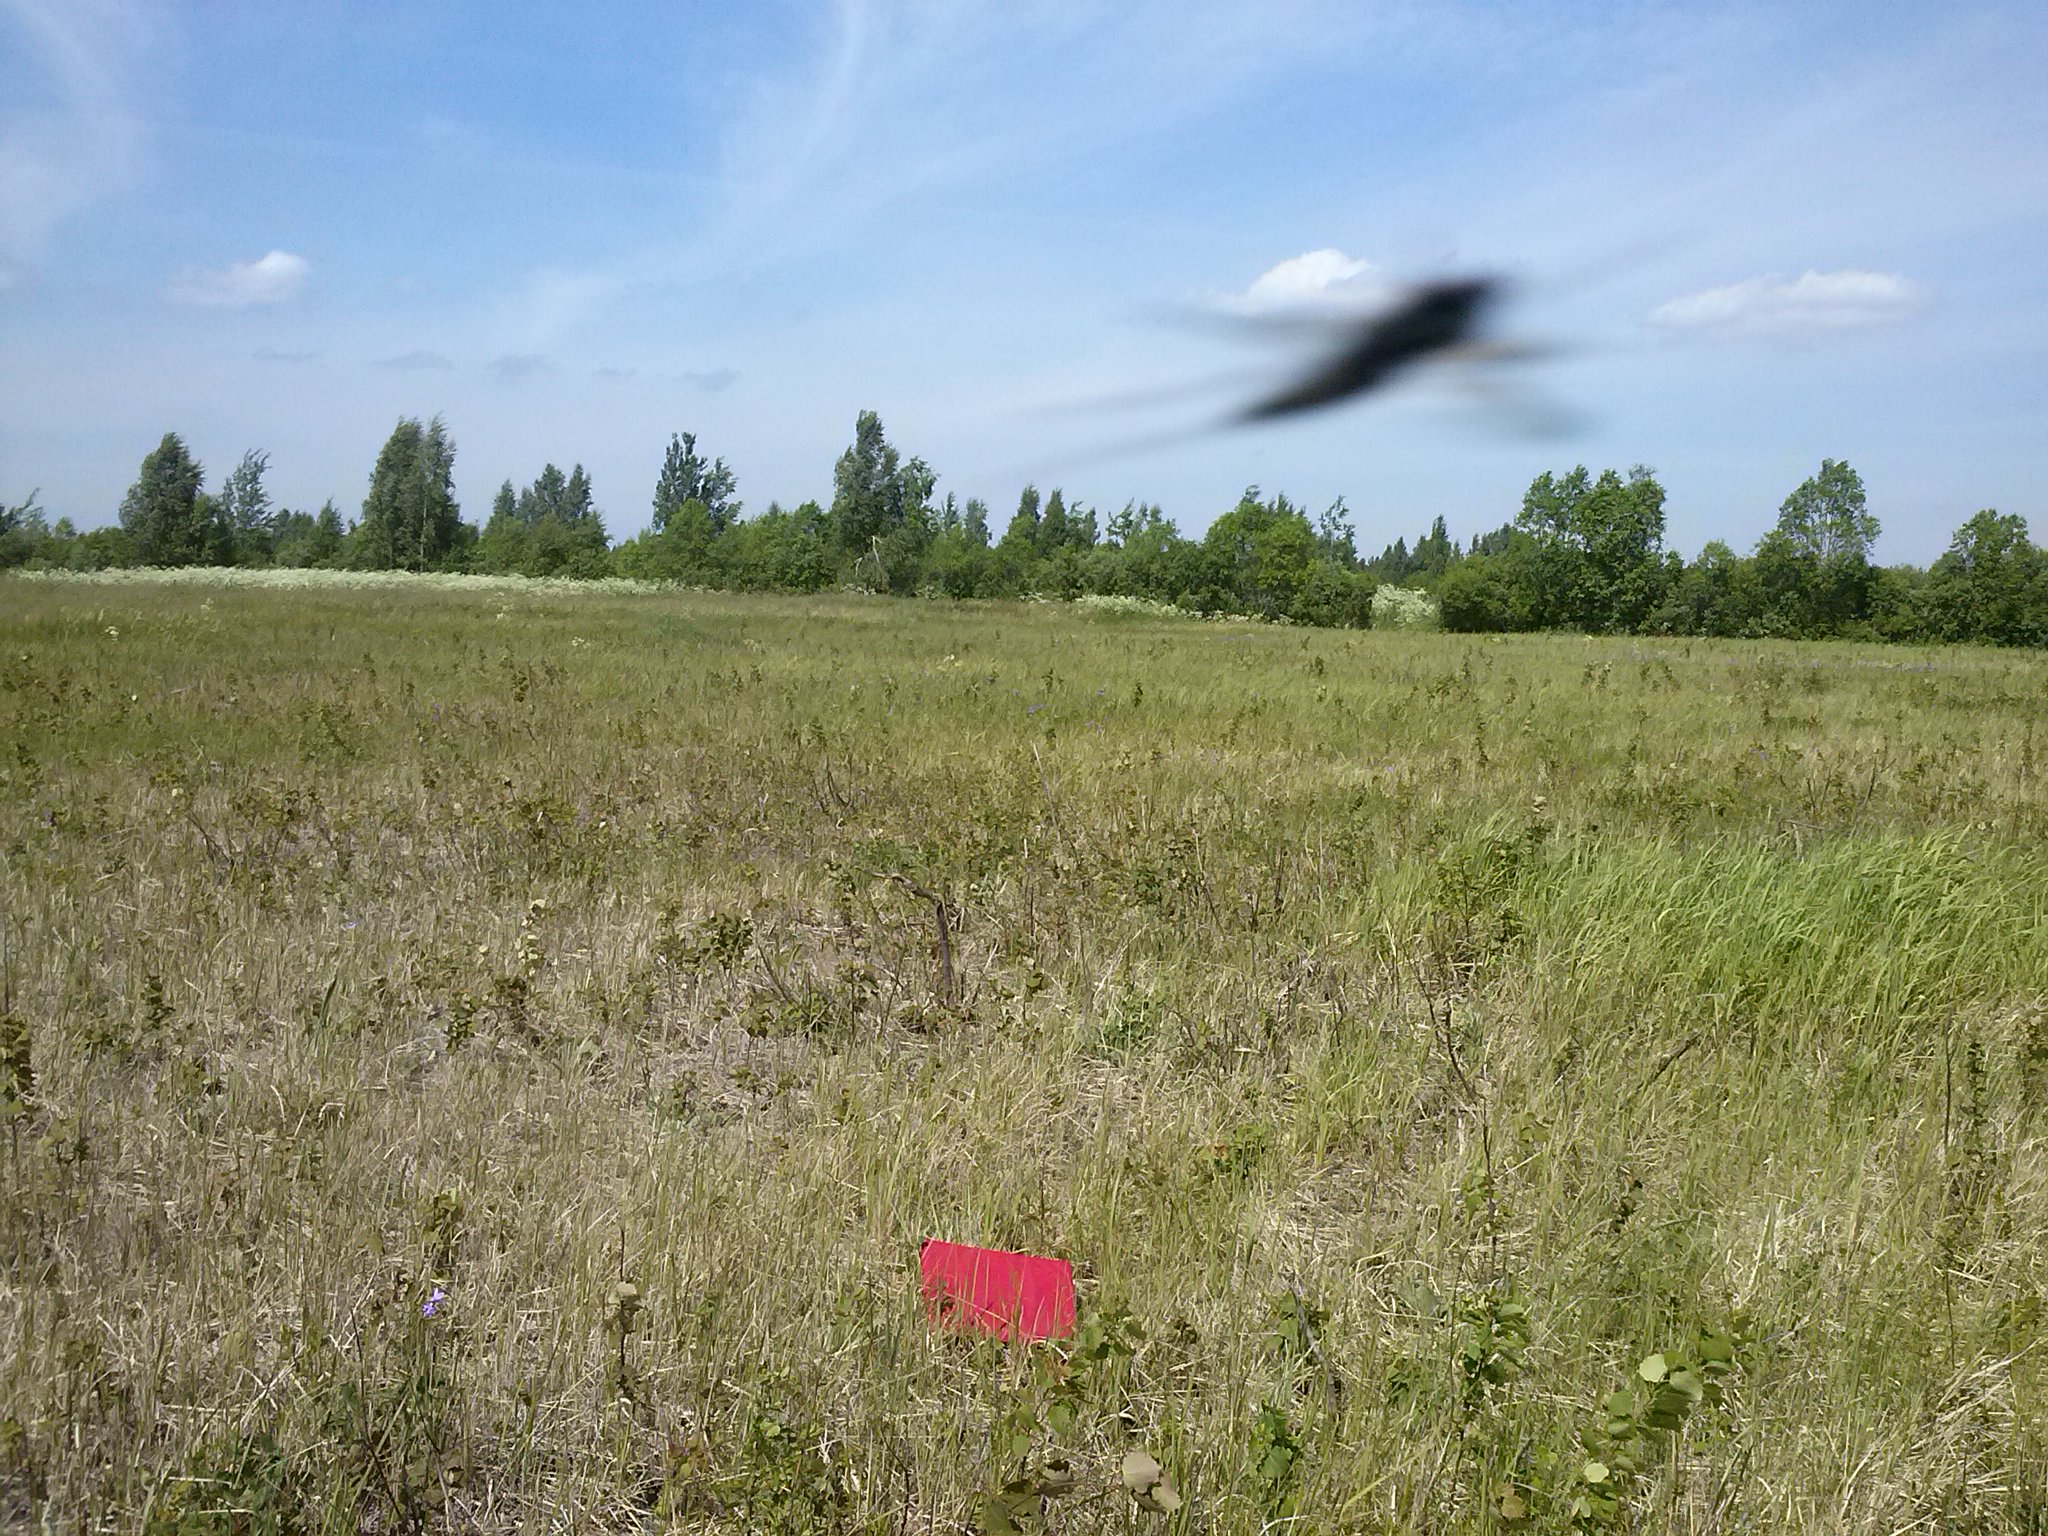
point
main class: Grassland
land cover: Grassland with sparse tree/shrub cover
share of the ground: > 75 %
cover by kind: herbaceous plants 85 %, shrubs 10 %, broadleaved forest trees 5 %
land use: Agriculture (excluding fallow land and kitchen gardens)
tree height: < 5 m
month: June
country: LV
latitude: 56.8254
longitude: 27.0234
